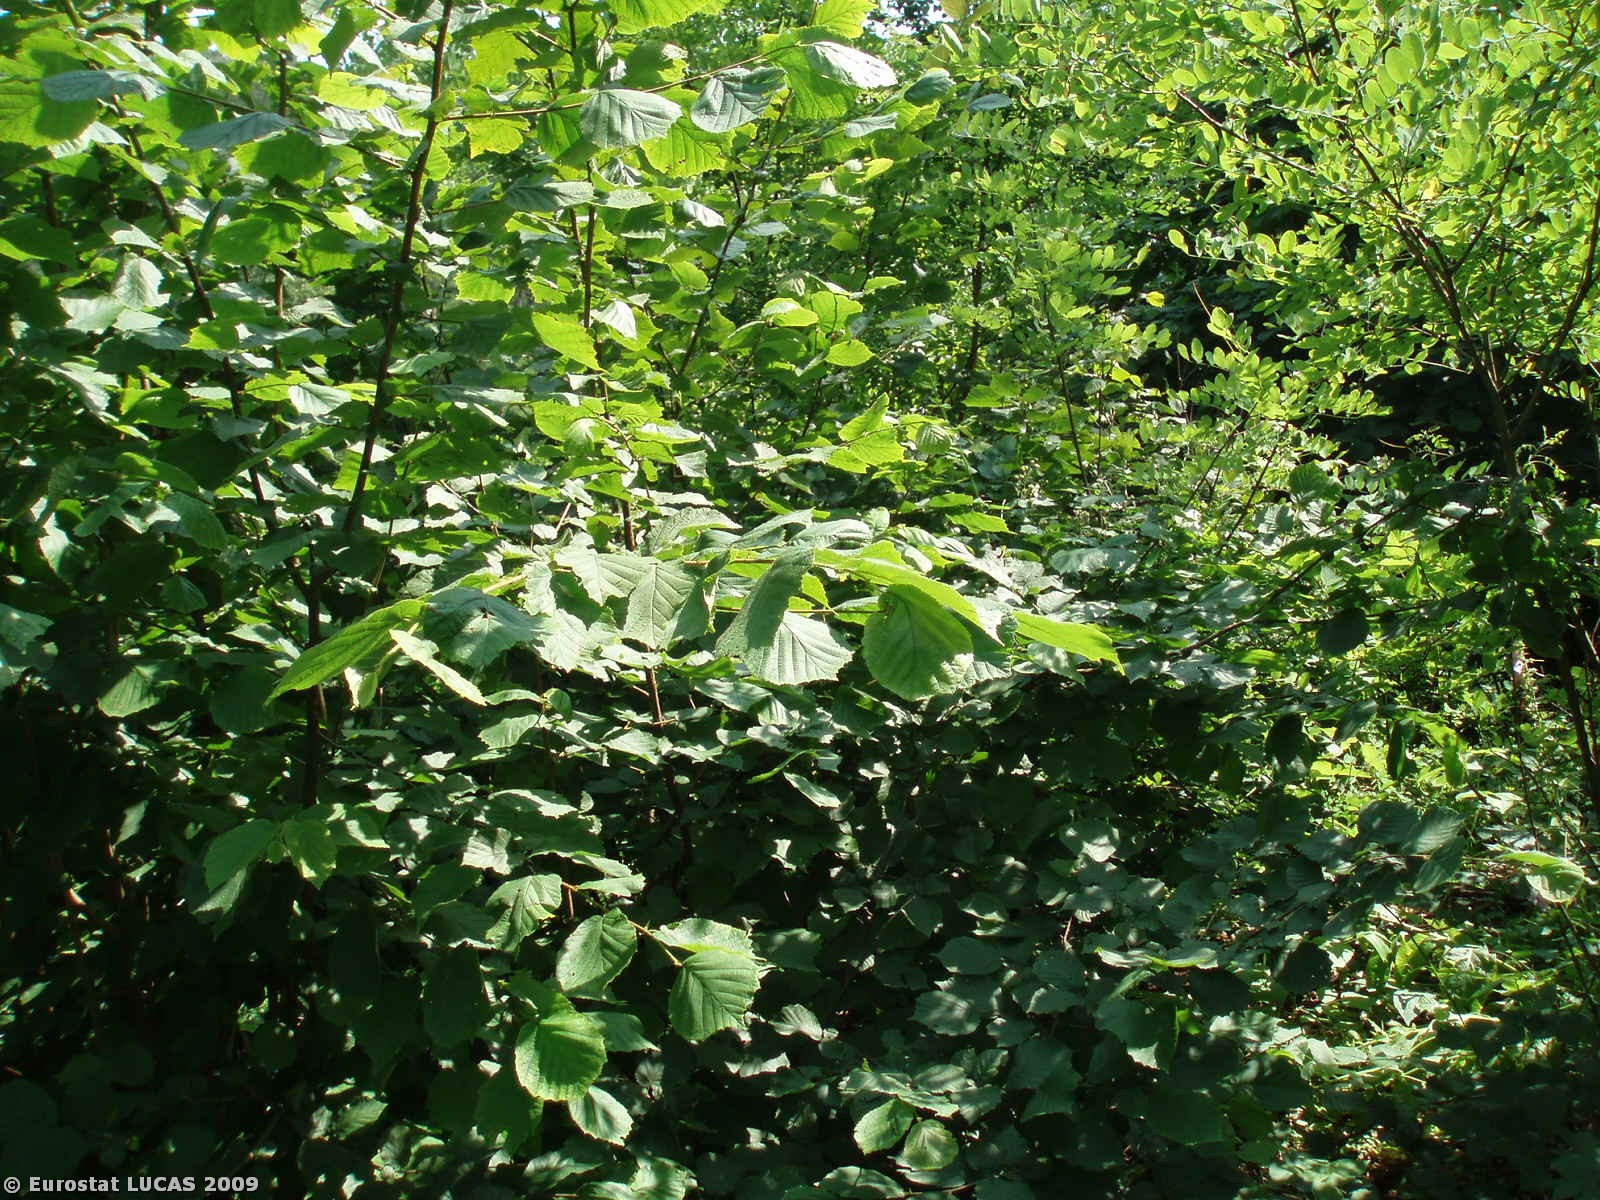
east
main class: Woodland
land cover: Broadleaved woodland
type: plantations and self-sown exotic forest
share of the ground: > 75 %
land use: Forestry
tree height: > 5 m
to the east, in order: Broadleaved woodland; Grassland with sparse tree/shrub cover; Broadleaved woodland; Mixed woodland; Tracks; Mixed woodland
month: July
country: CZ
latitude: 49.9376
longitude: 14.3904
